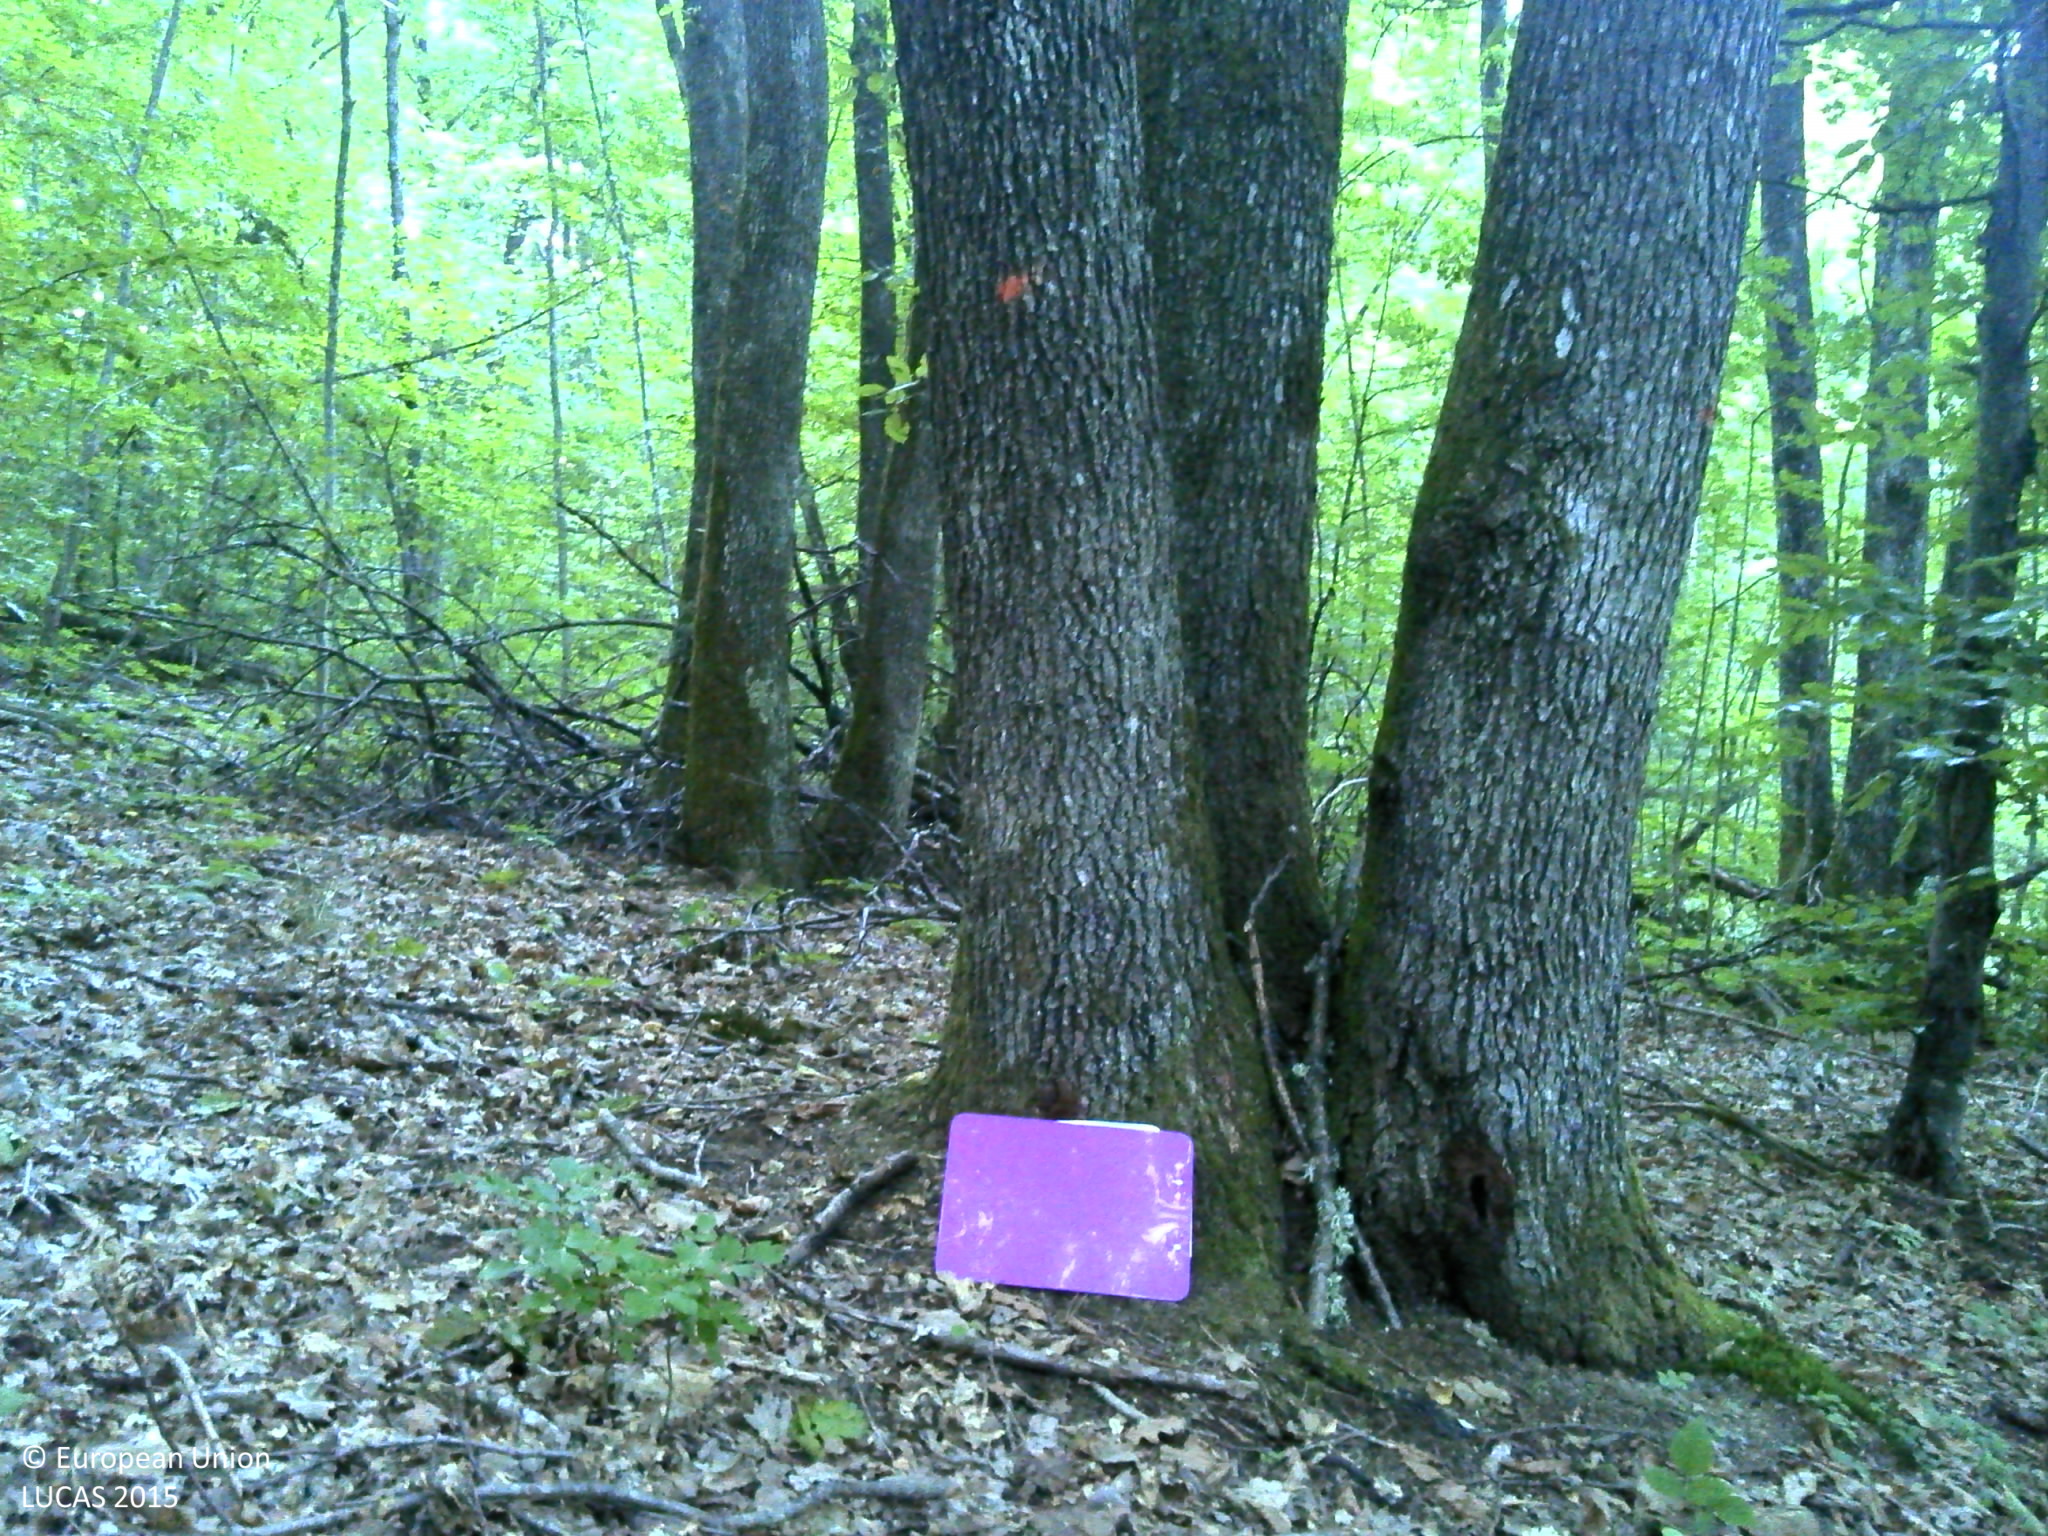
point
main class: Woodland
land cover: Broadleaved woodland
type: acidophilous oak and oak-birch forest
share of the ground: > 75 %
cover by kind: broadleaved forest trees 100 %
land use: Forestry
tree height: > 5 m
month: August
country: HR
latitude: 45.1555
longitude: 16.2676
